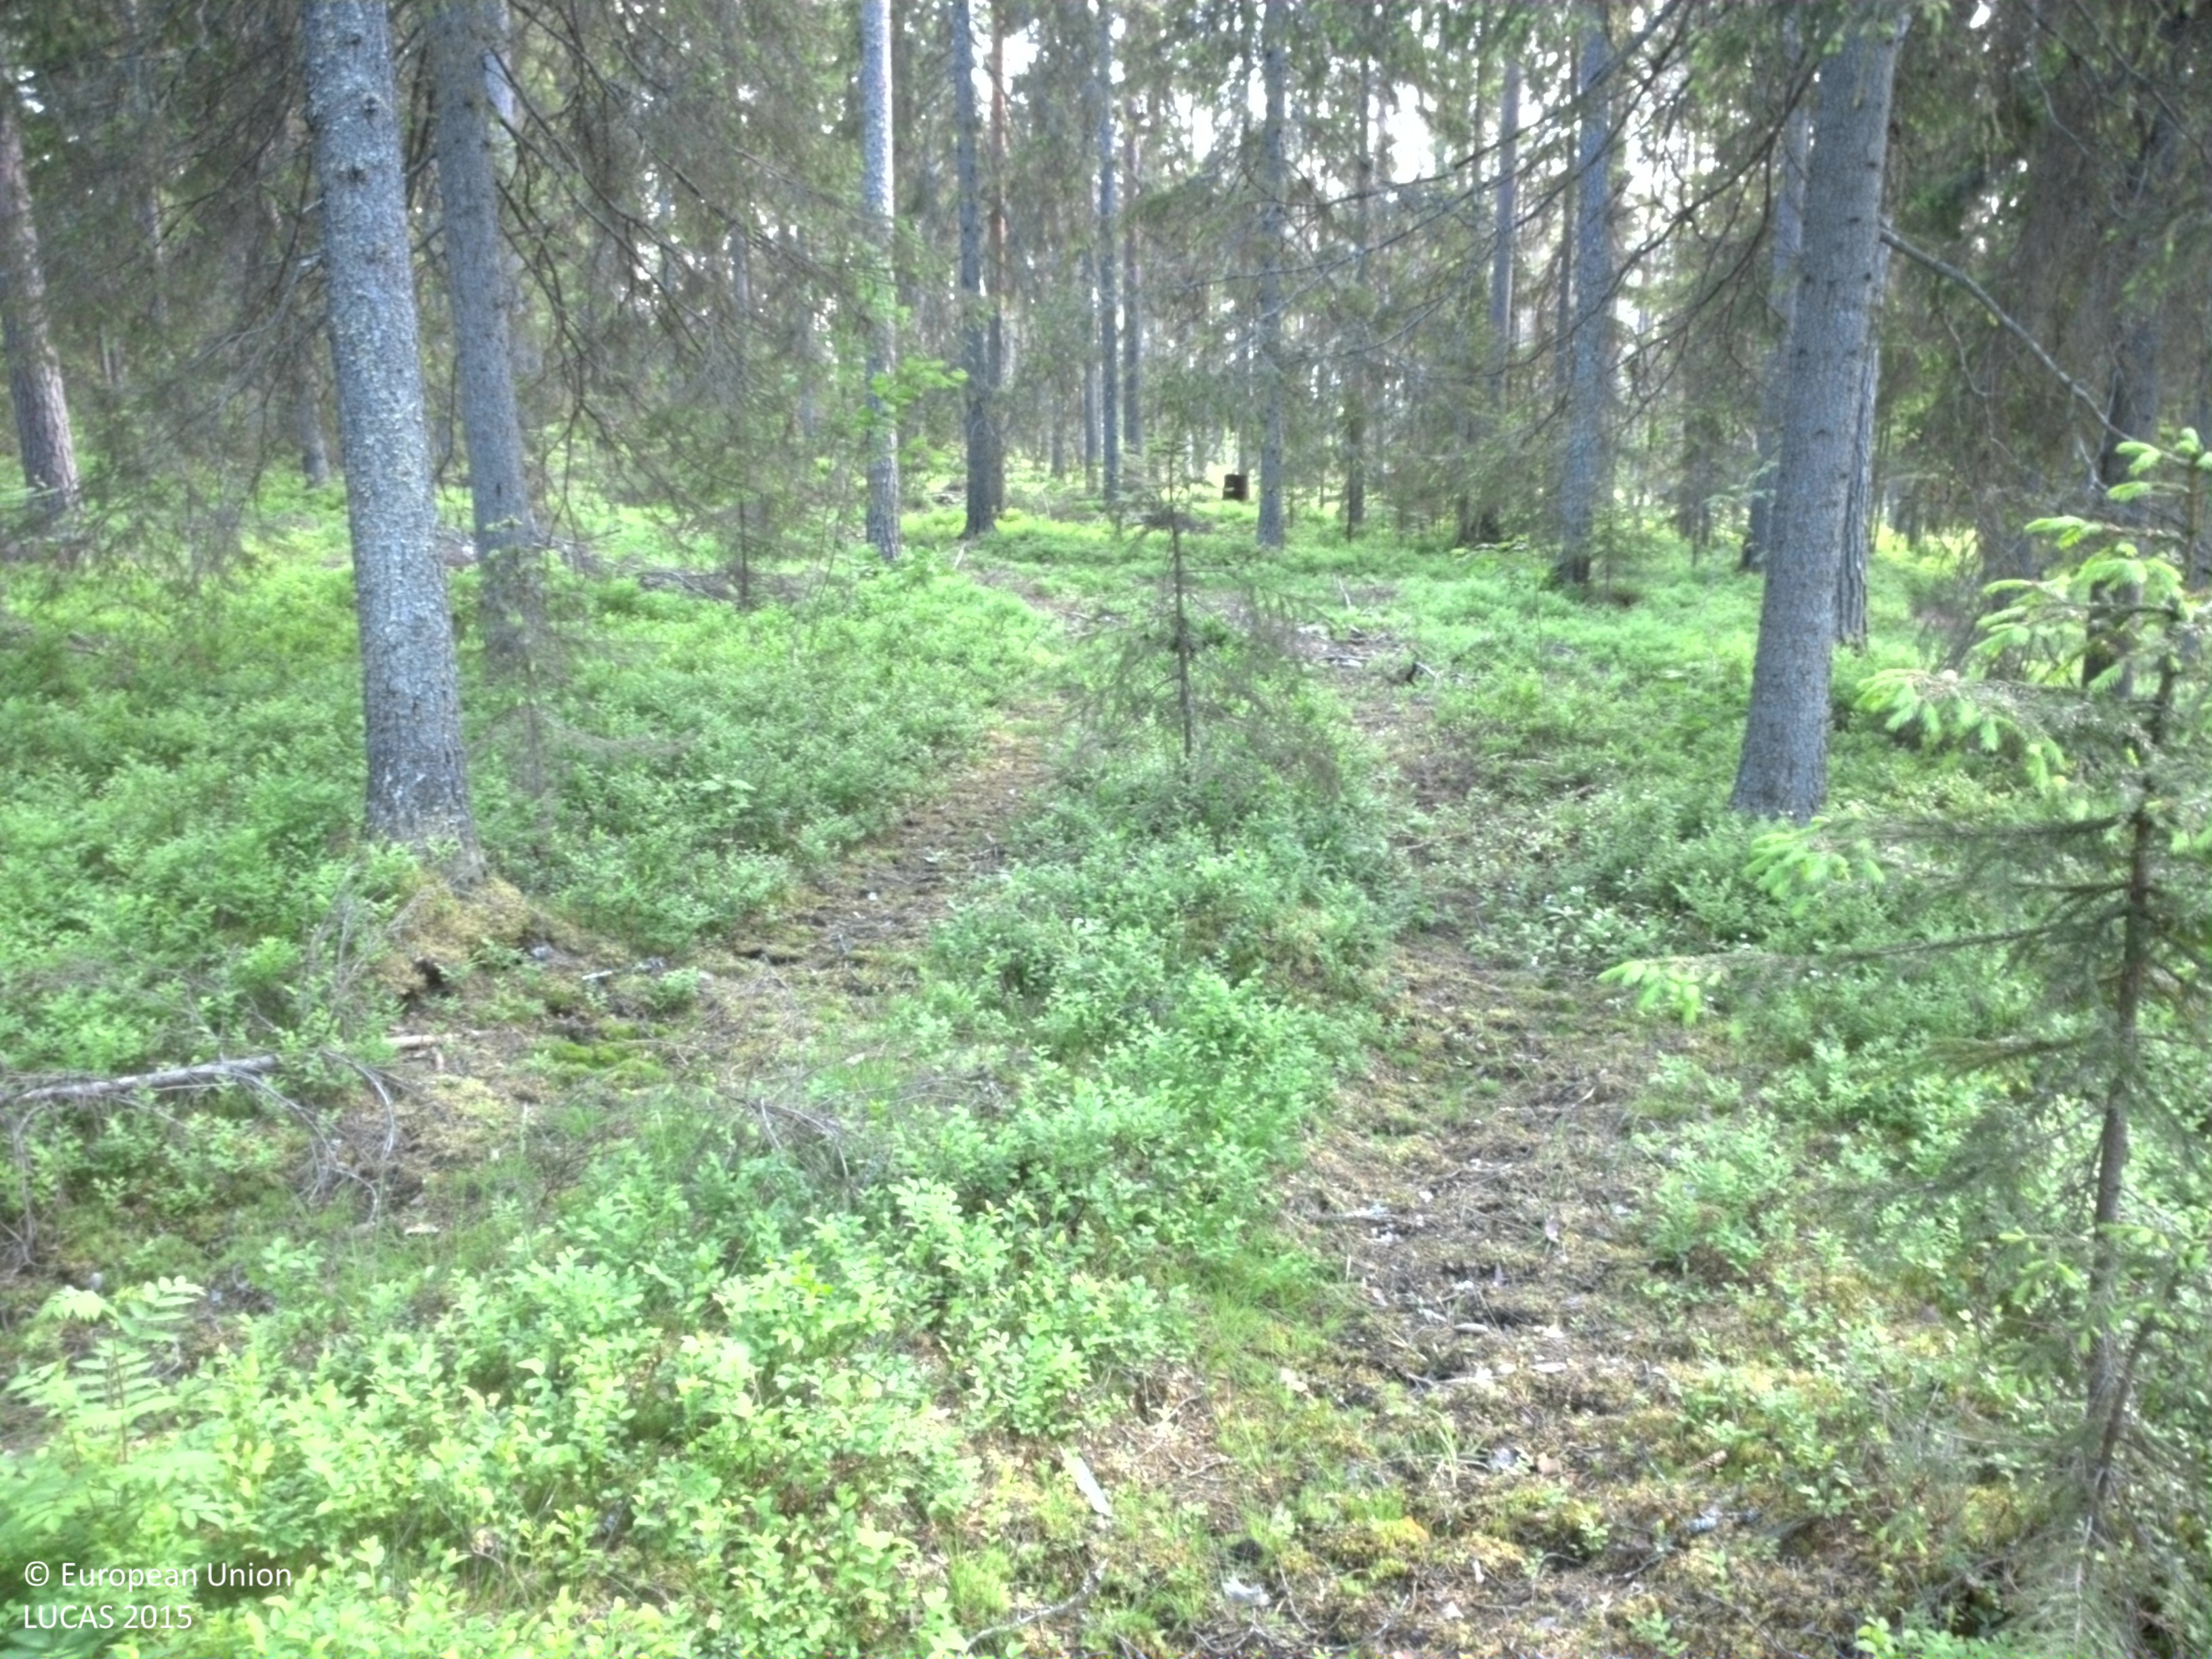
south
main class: Woodland
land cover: Pine dominated coniferous woodland
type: boreal forest
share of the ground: 25 - 50 %
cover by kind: shrubs 60 %, coniferous forest trees 40 %
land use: Forestry
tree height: > 5 m
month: June
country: SE
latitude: 66.3229
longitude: 22.7639
